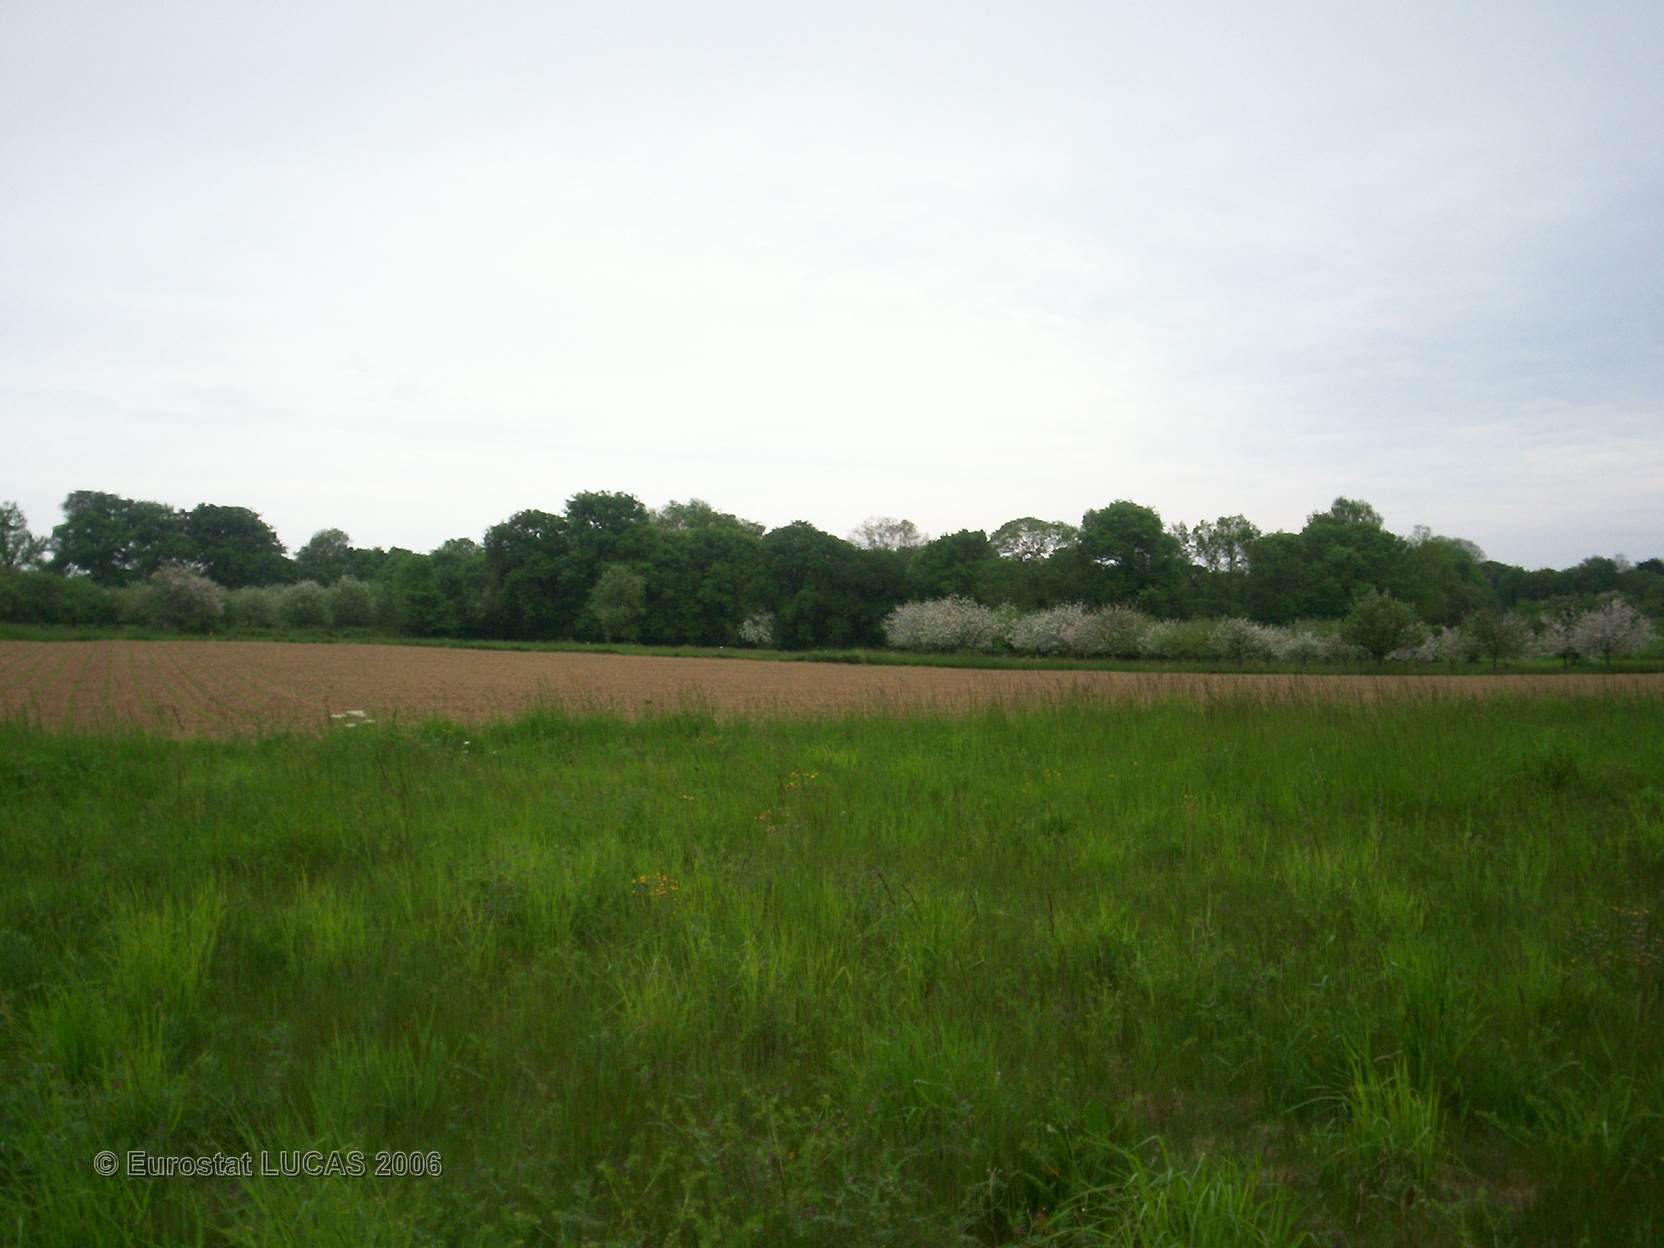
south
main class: Grassland
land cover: Grassland without tree/shrub cover
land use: Fallow land
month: May
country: FR
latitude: 47.7810
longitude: -3.5699
